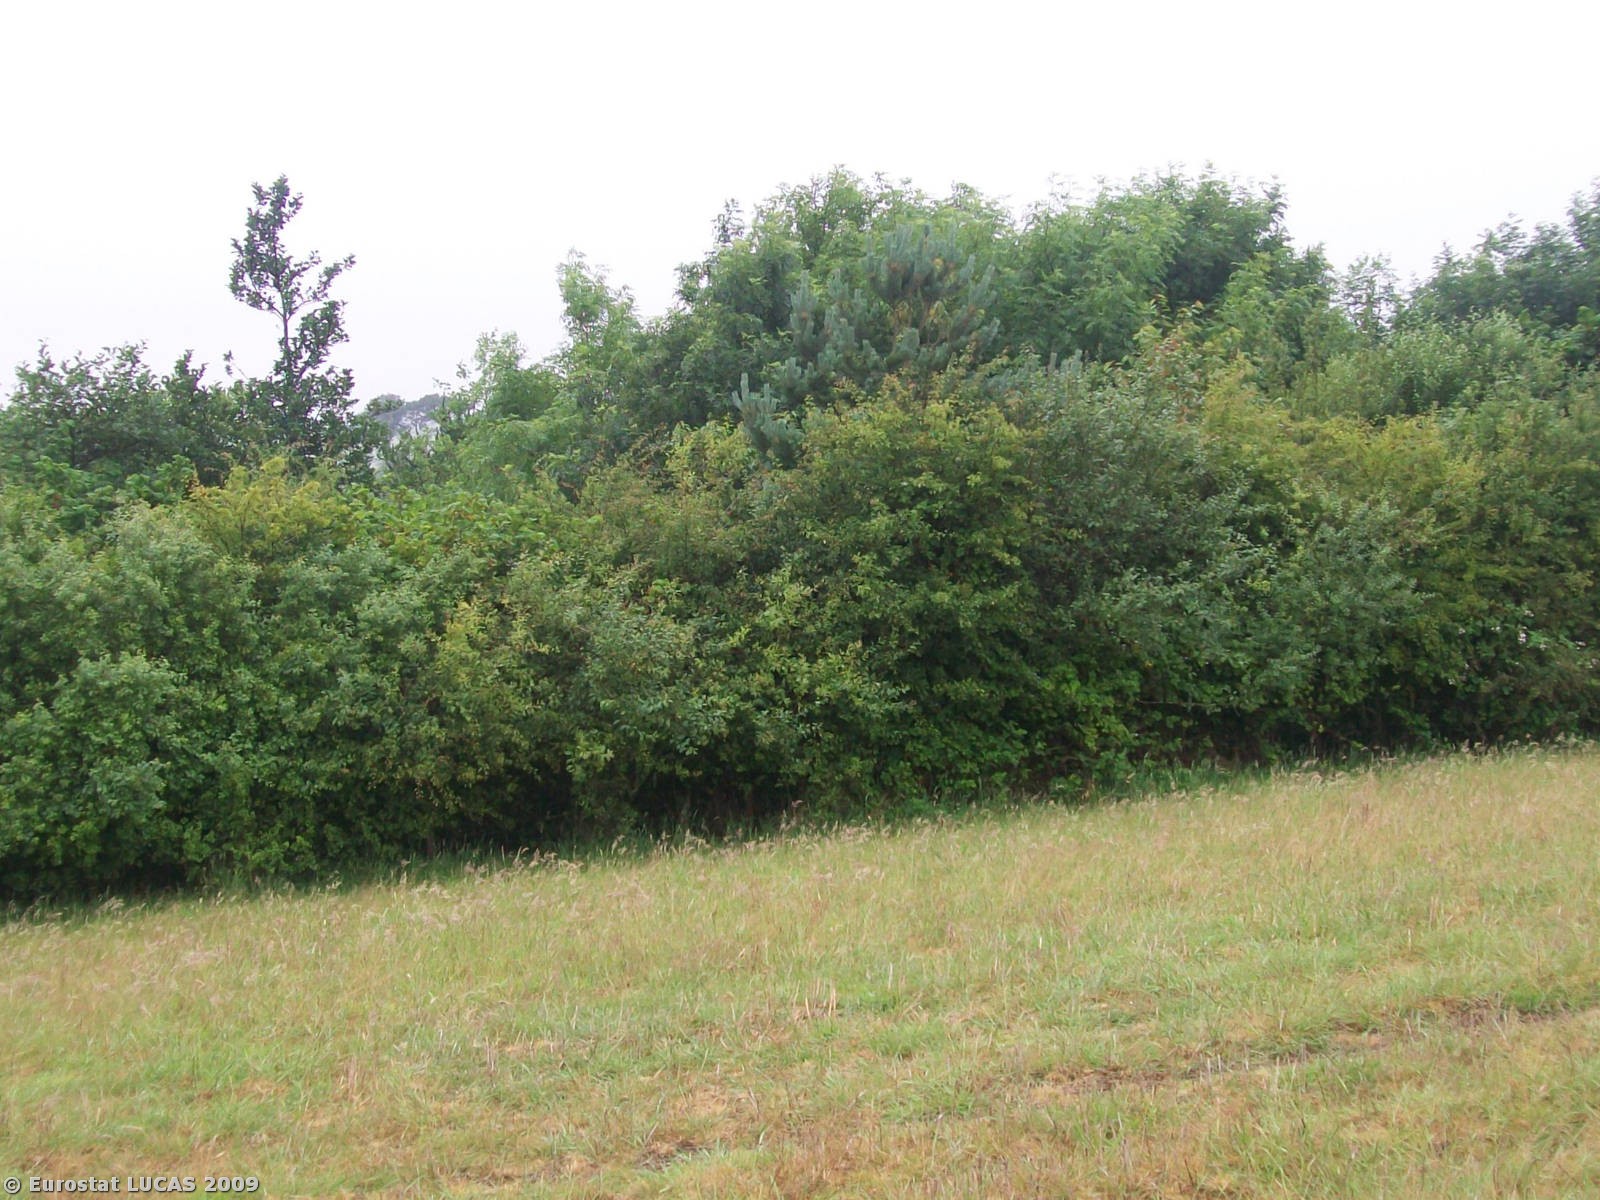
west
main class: Grassland
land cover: Grassland without tree/shrub cover
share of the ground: > 75 %
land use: Agriculture (excluding fallow land and kitchen gardens)
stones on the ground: < 10 %
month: July
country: GB
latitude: 50.3019
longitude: -5.1269
